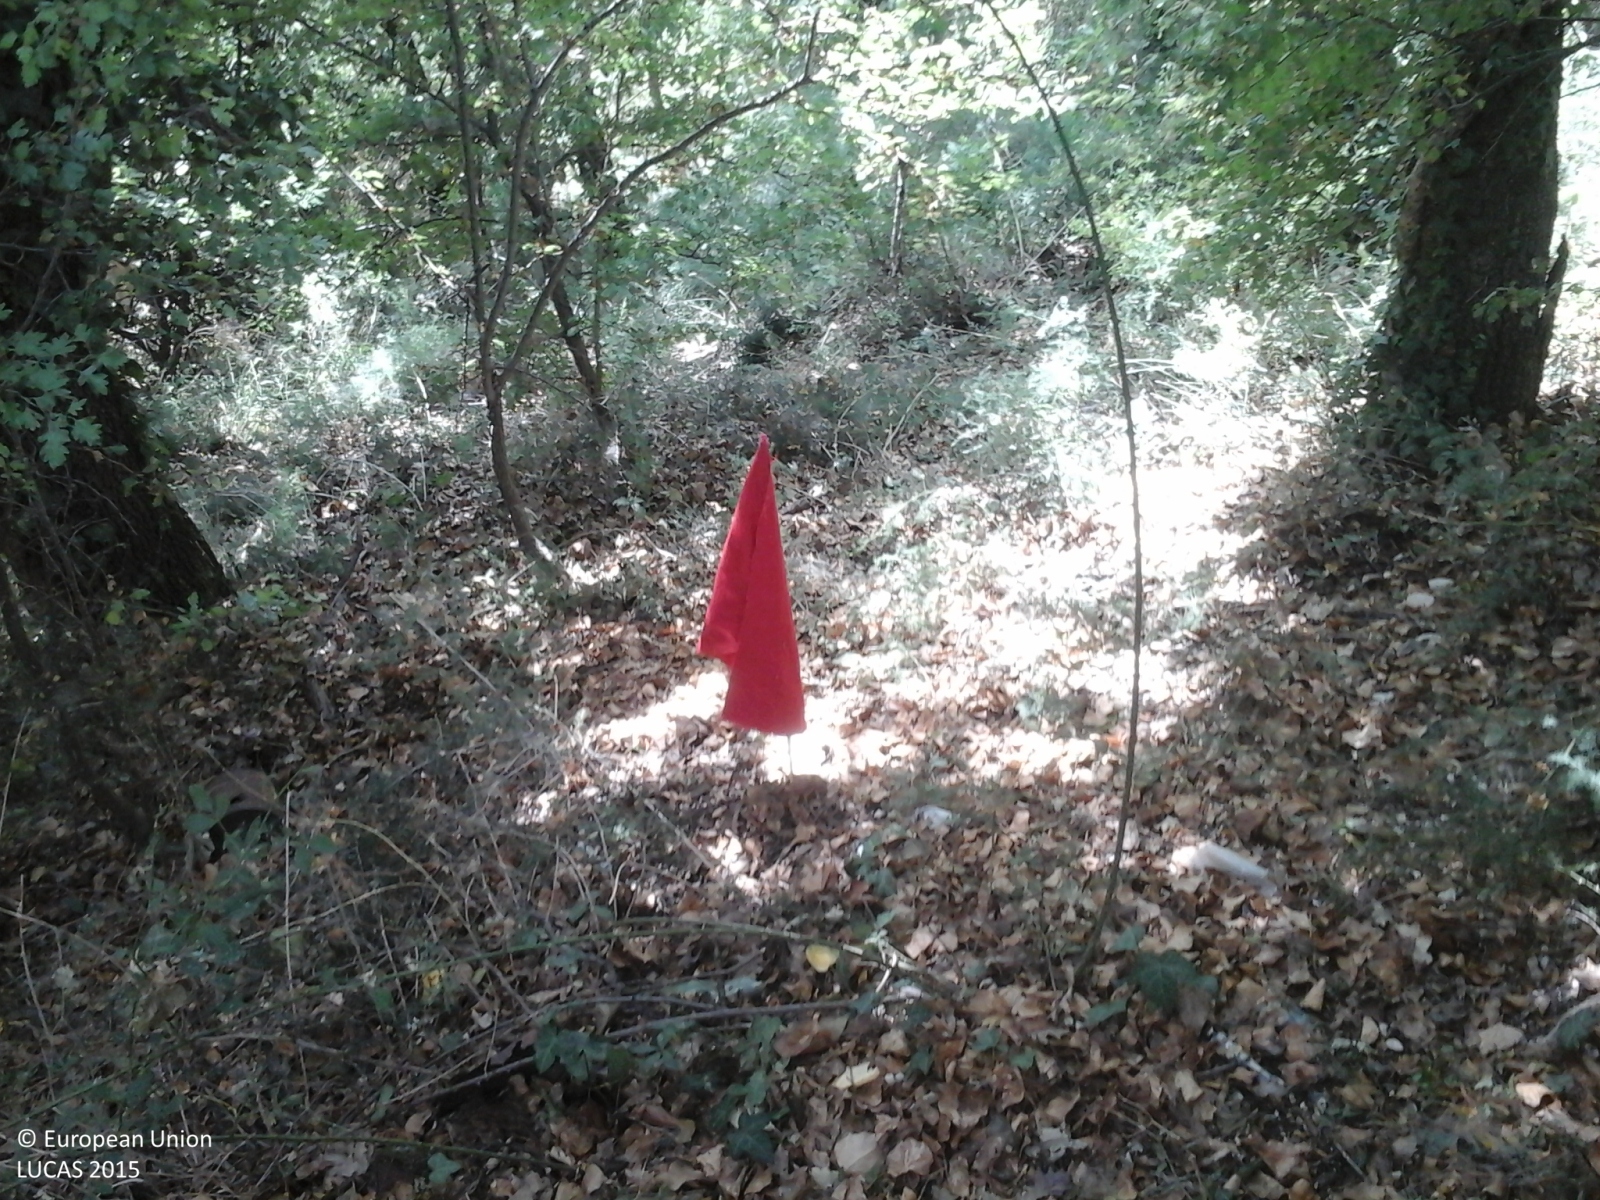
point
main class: Woodland
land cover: Broadleaved woodland
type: thermophilous deciduous forest
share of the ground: > 75 %
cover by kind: broadleaved forest trees 95 %, shrubs 5 %
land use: Forestry
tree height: > 5 m
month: July
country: IT
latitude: 43.3203
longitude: 13.3823
